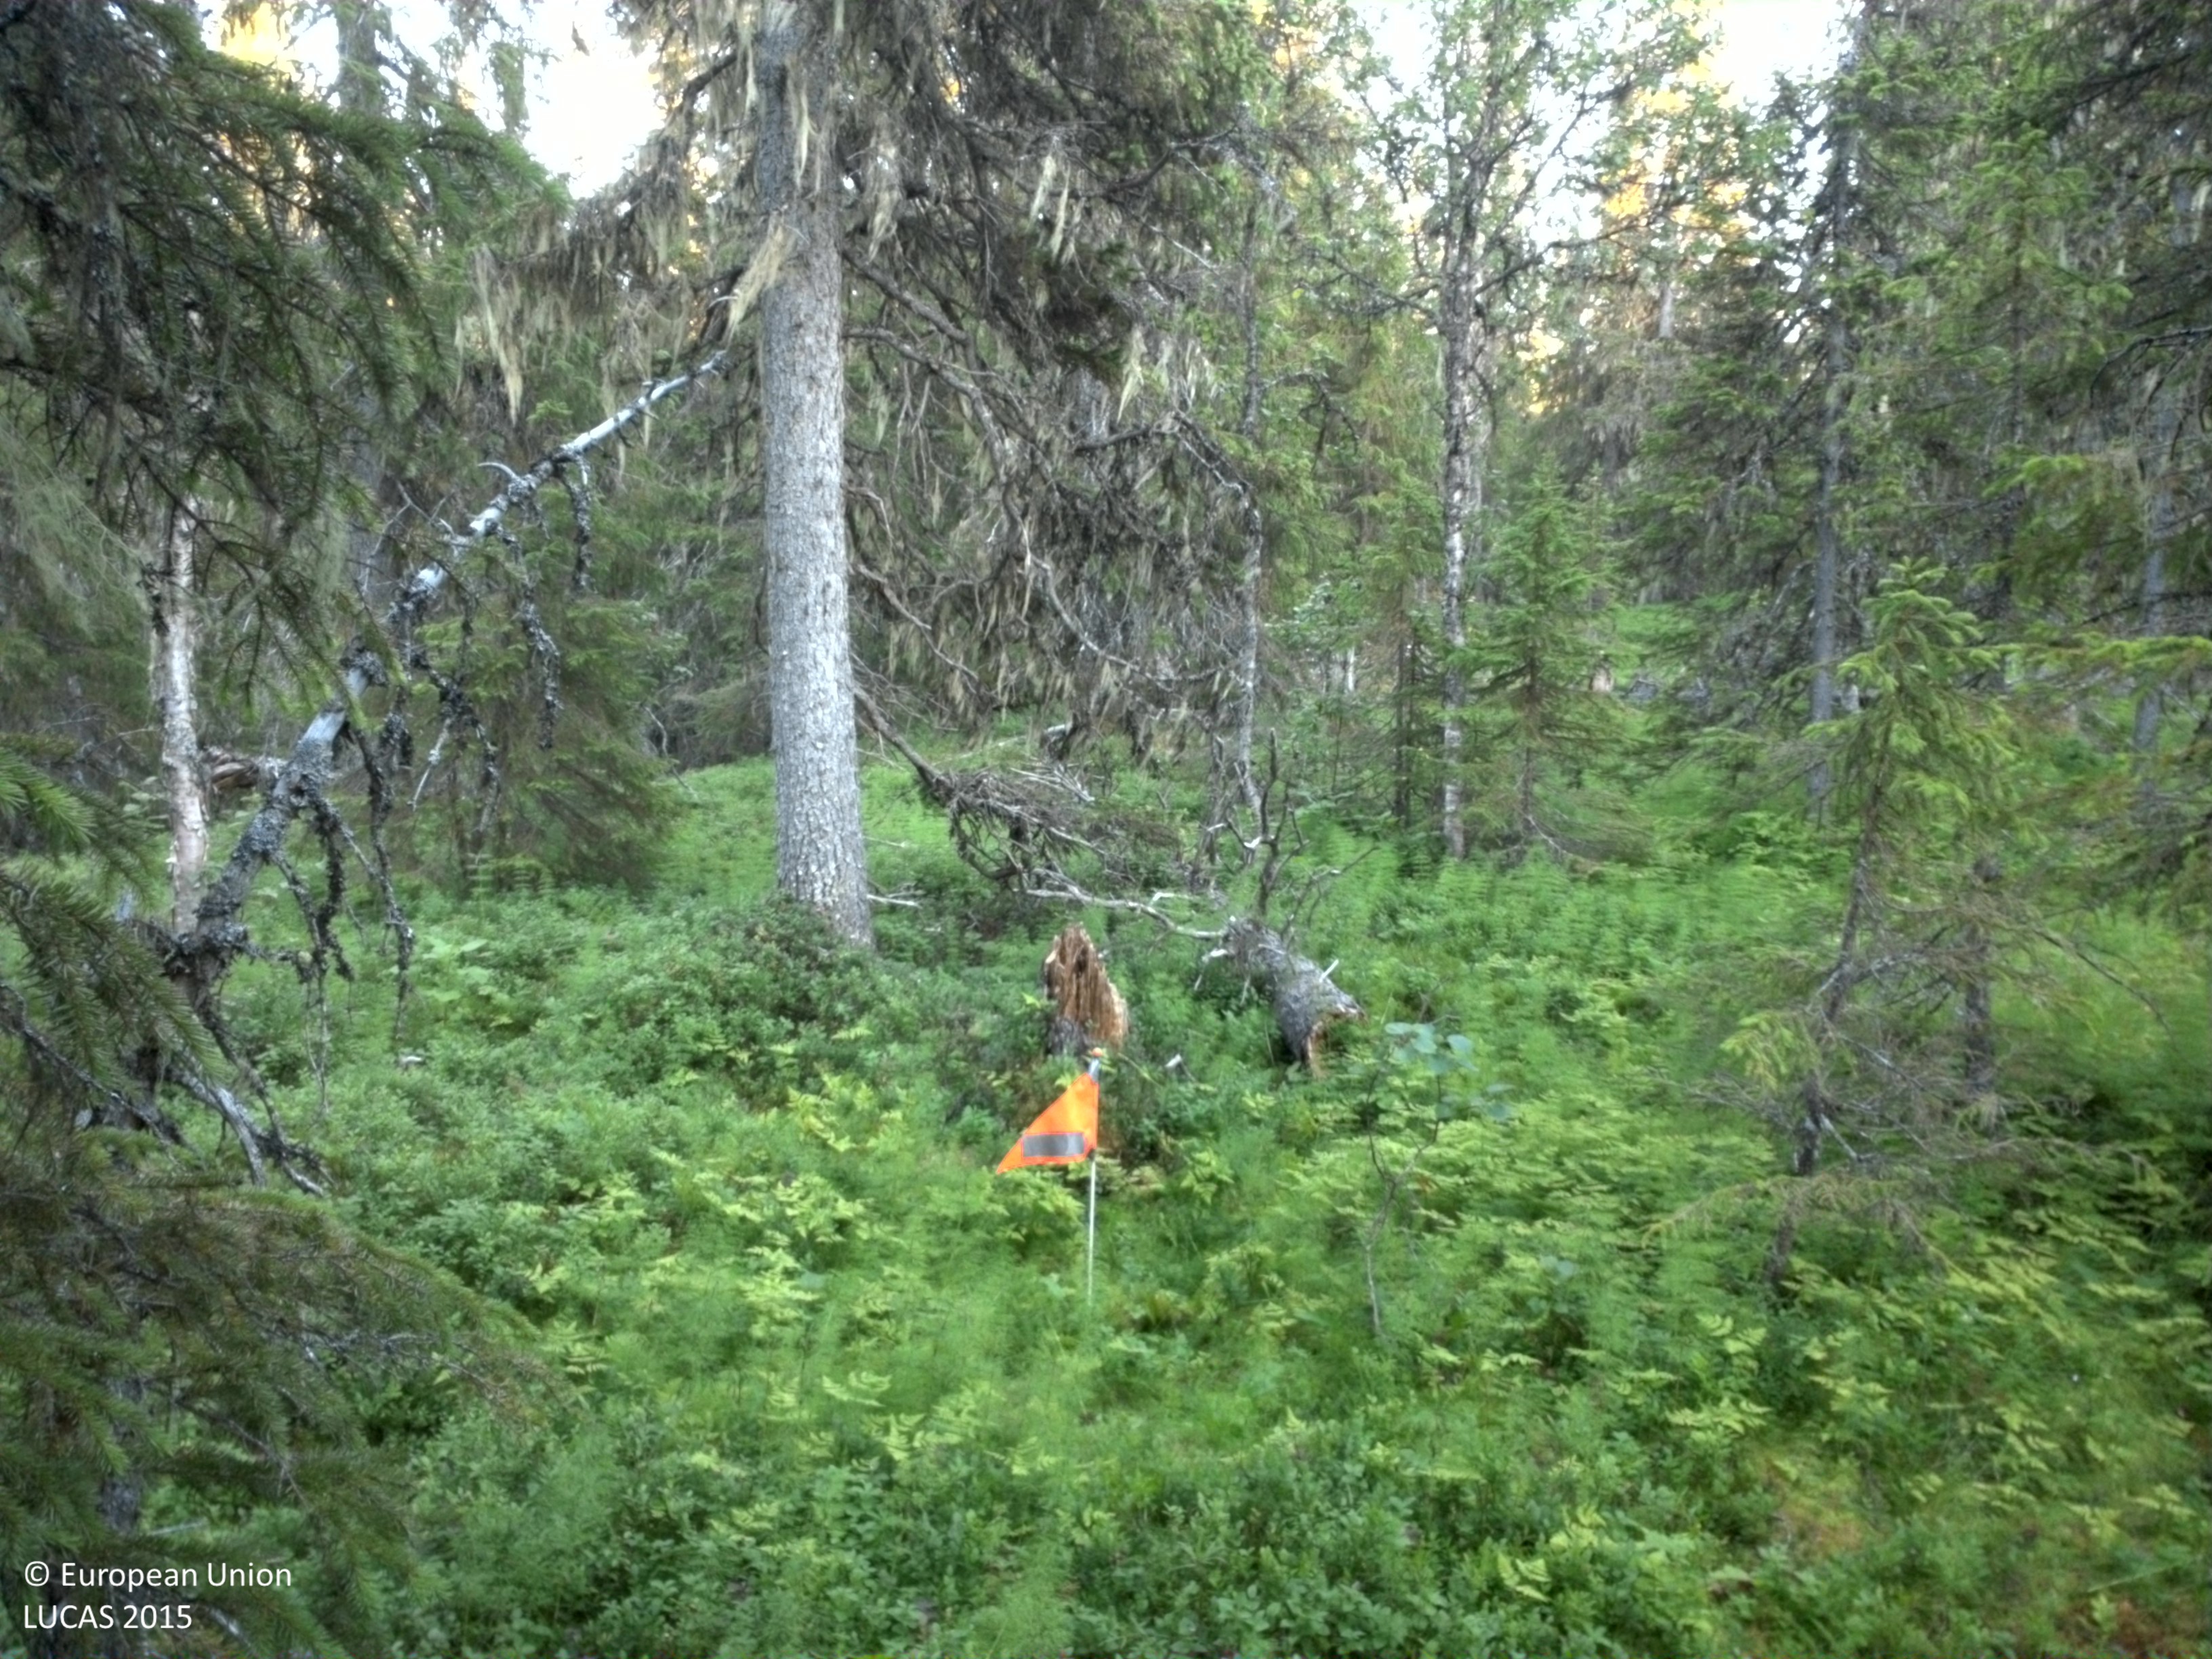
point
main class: Woodland
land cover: Spruce dominated coniferous woodland
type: boreal forest
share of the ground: 25 - 50 %
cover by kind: coniferous forest trees 30 %, herbaceous plants 25 %, shrubs 20 %, lichens and mosses 20 %, broadleaved forest trees 5 %
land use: Forestry
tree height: > 5 m
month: August
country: SE
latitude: 64.7963
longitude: 15.8815
